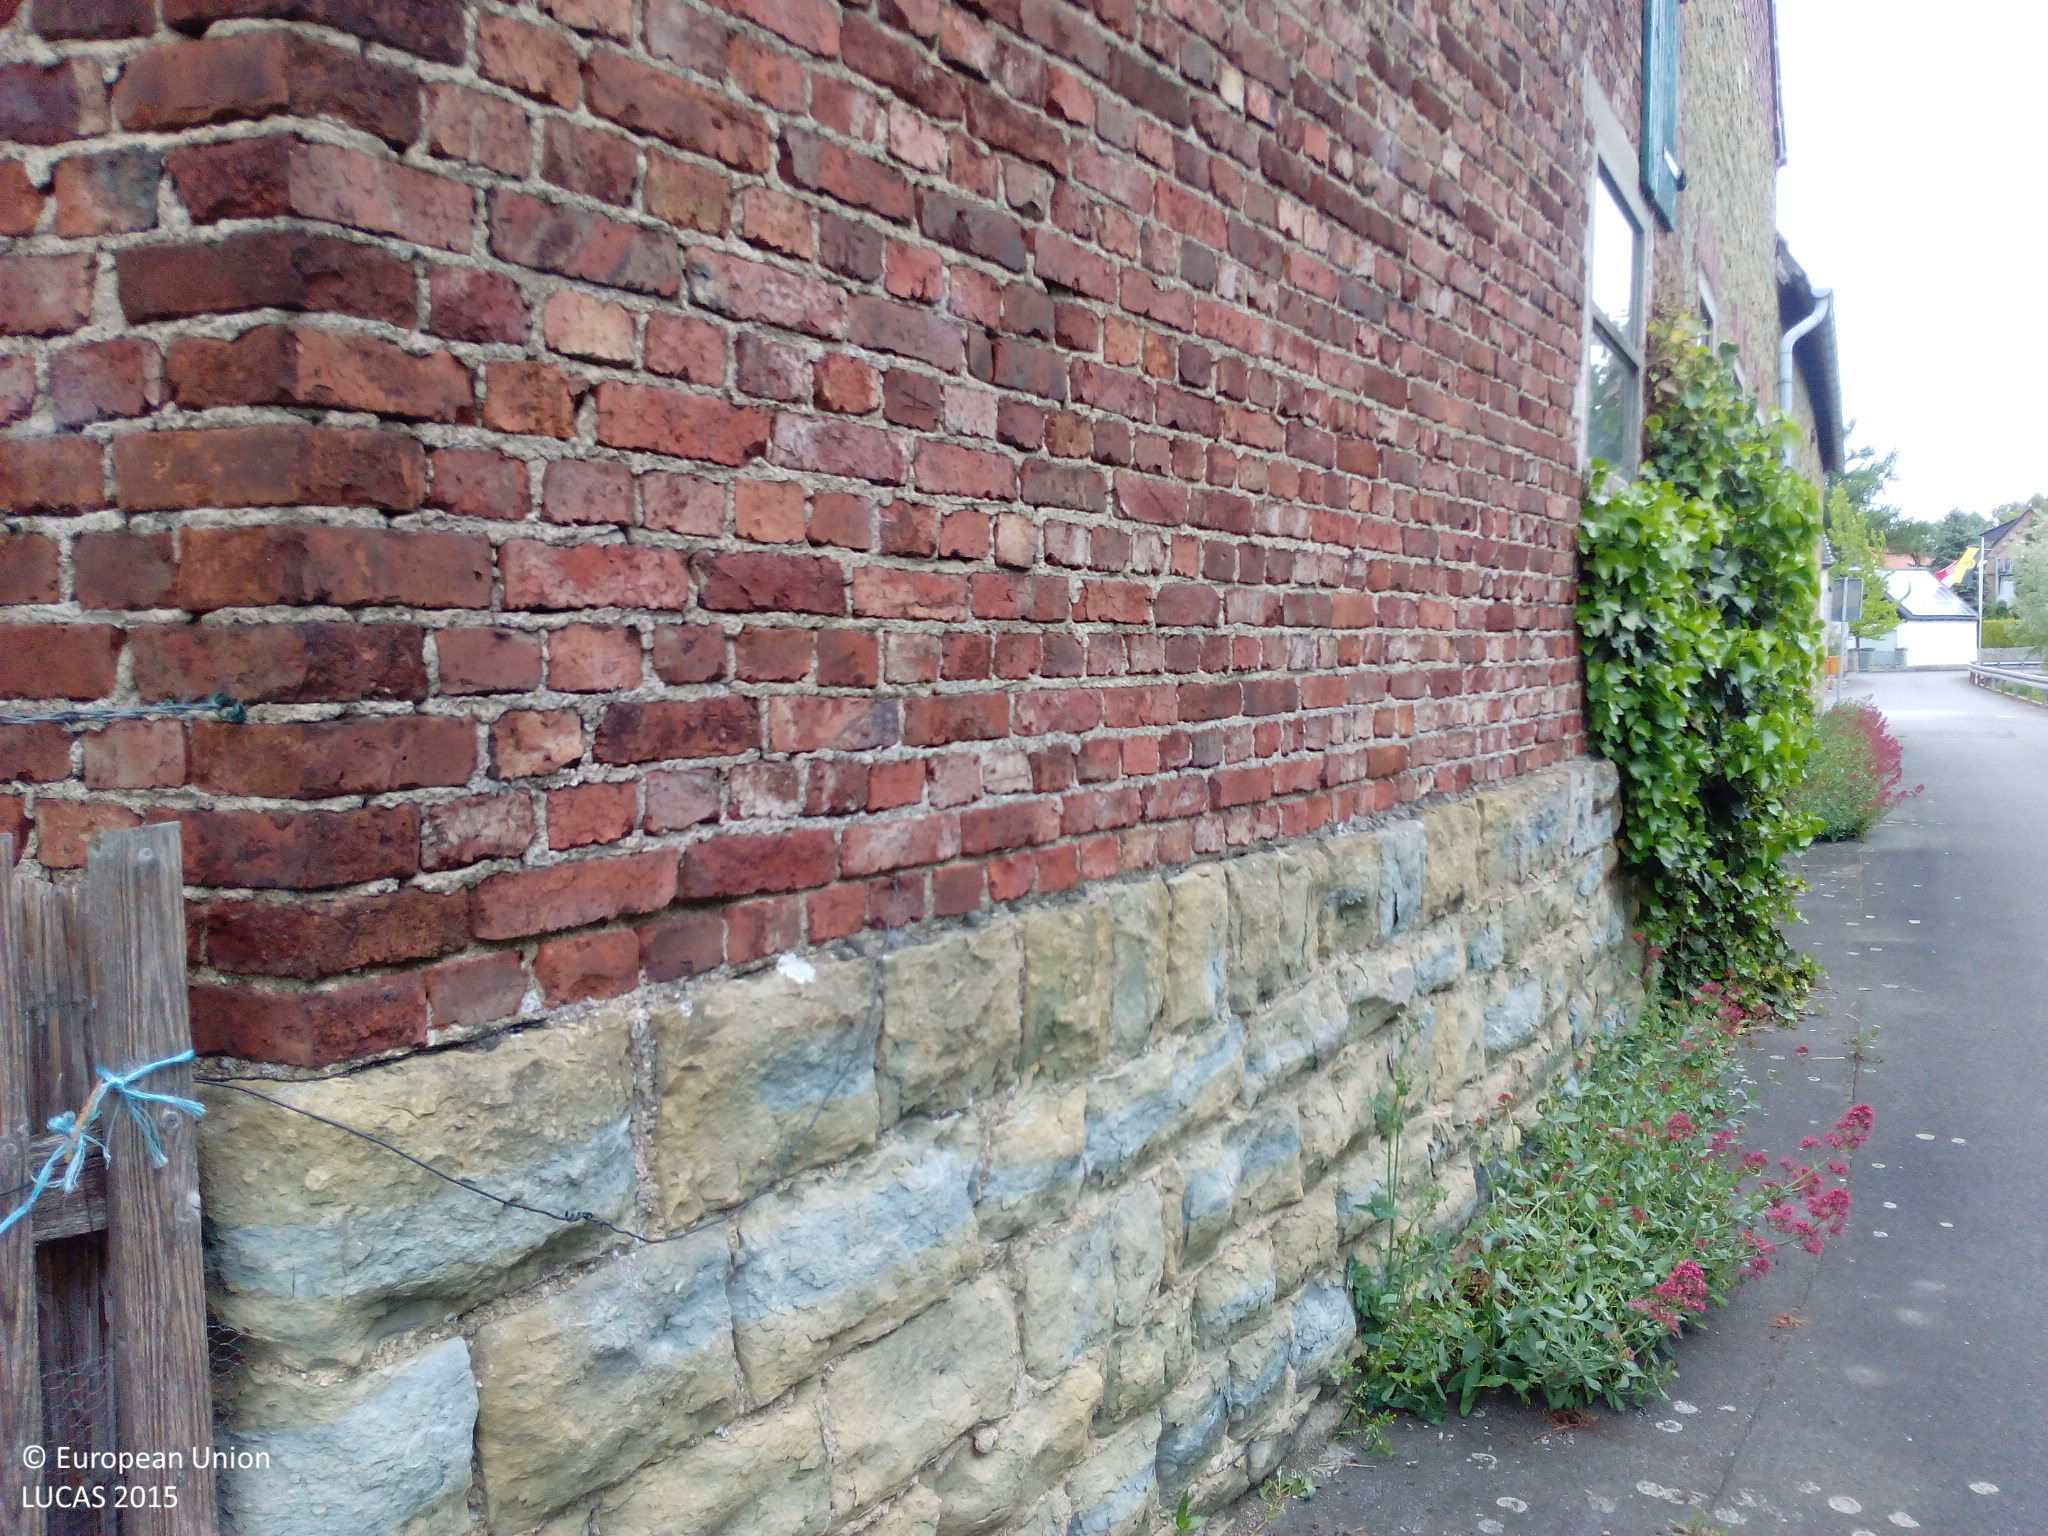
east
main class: Cropland
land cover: Floriculture and ornamental plants
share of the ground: > 75 %
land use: Residential
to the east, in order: Floriculture and ornamental plants; Artificial constructions in urban areas; Sugar beet
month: June
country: DE
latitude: 51.5514
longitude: 7.9957
